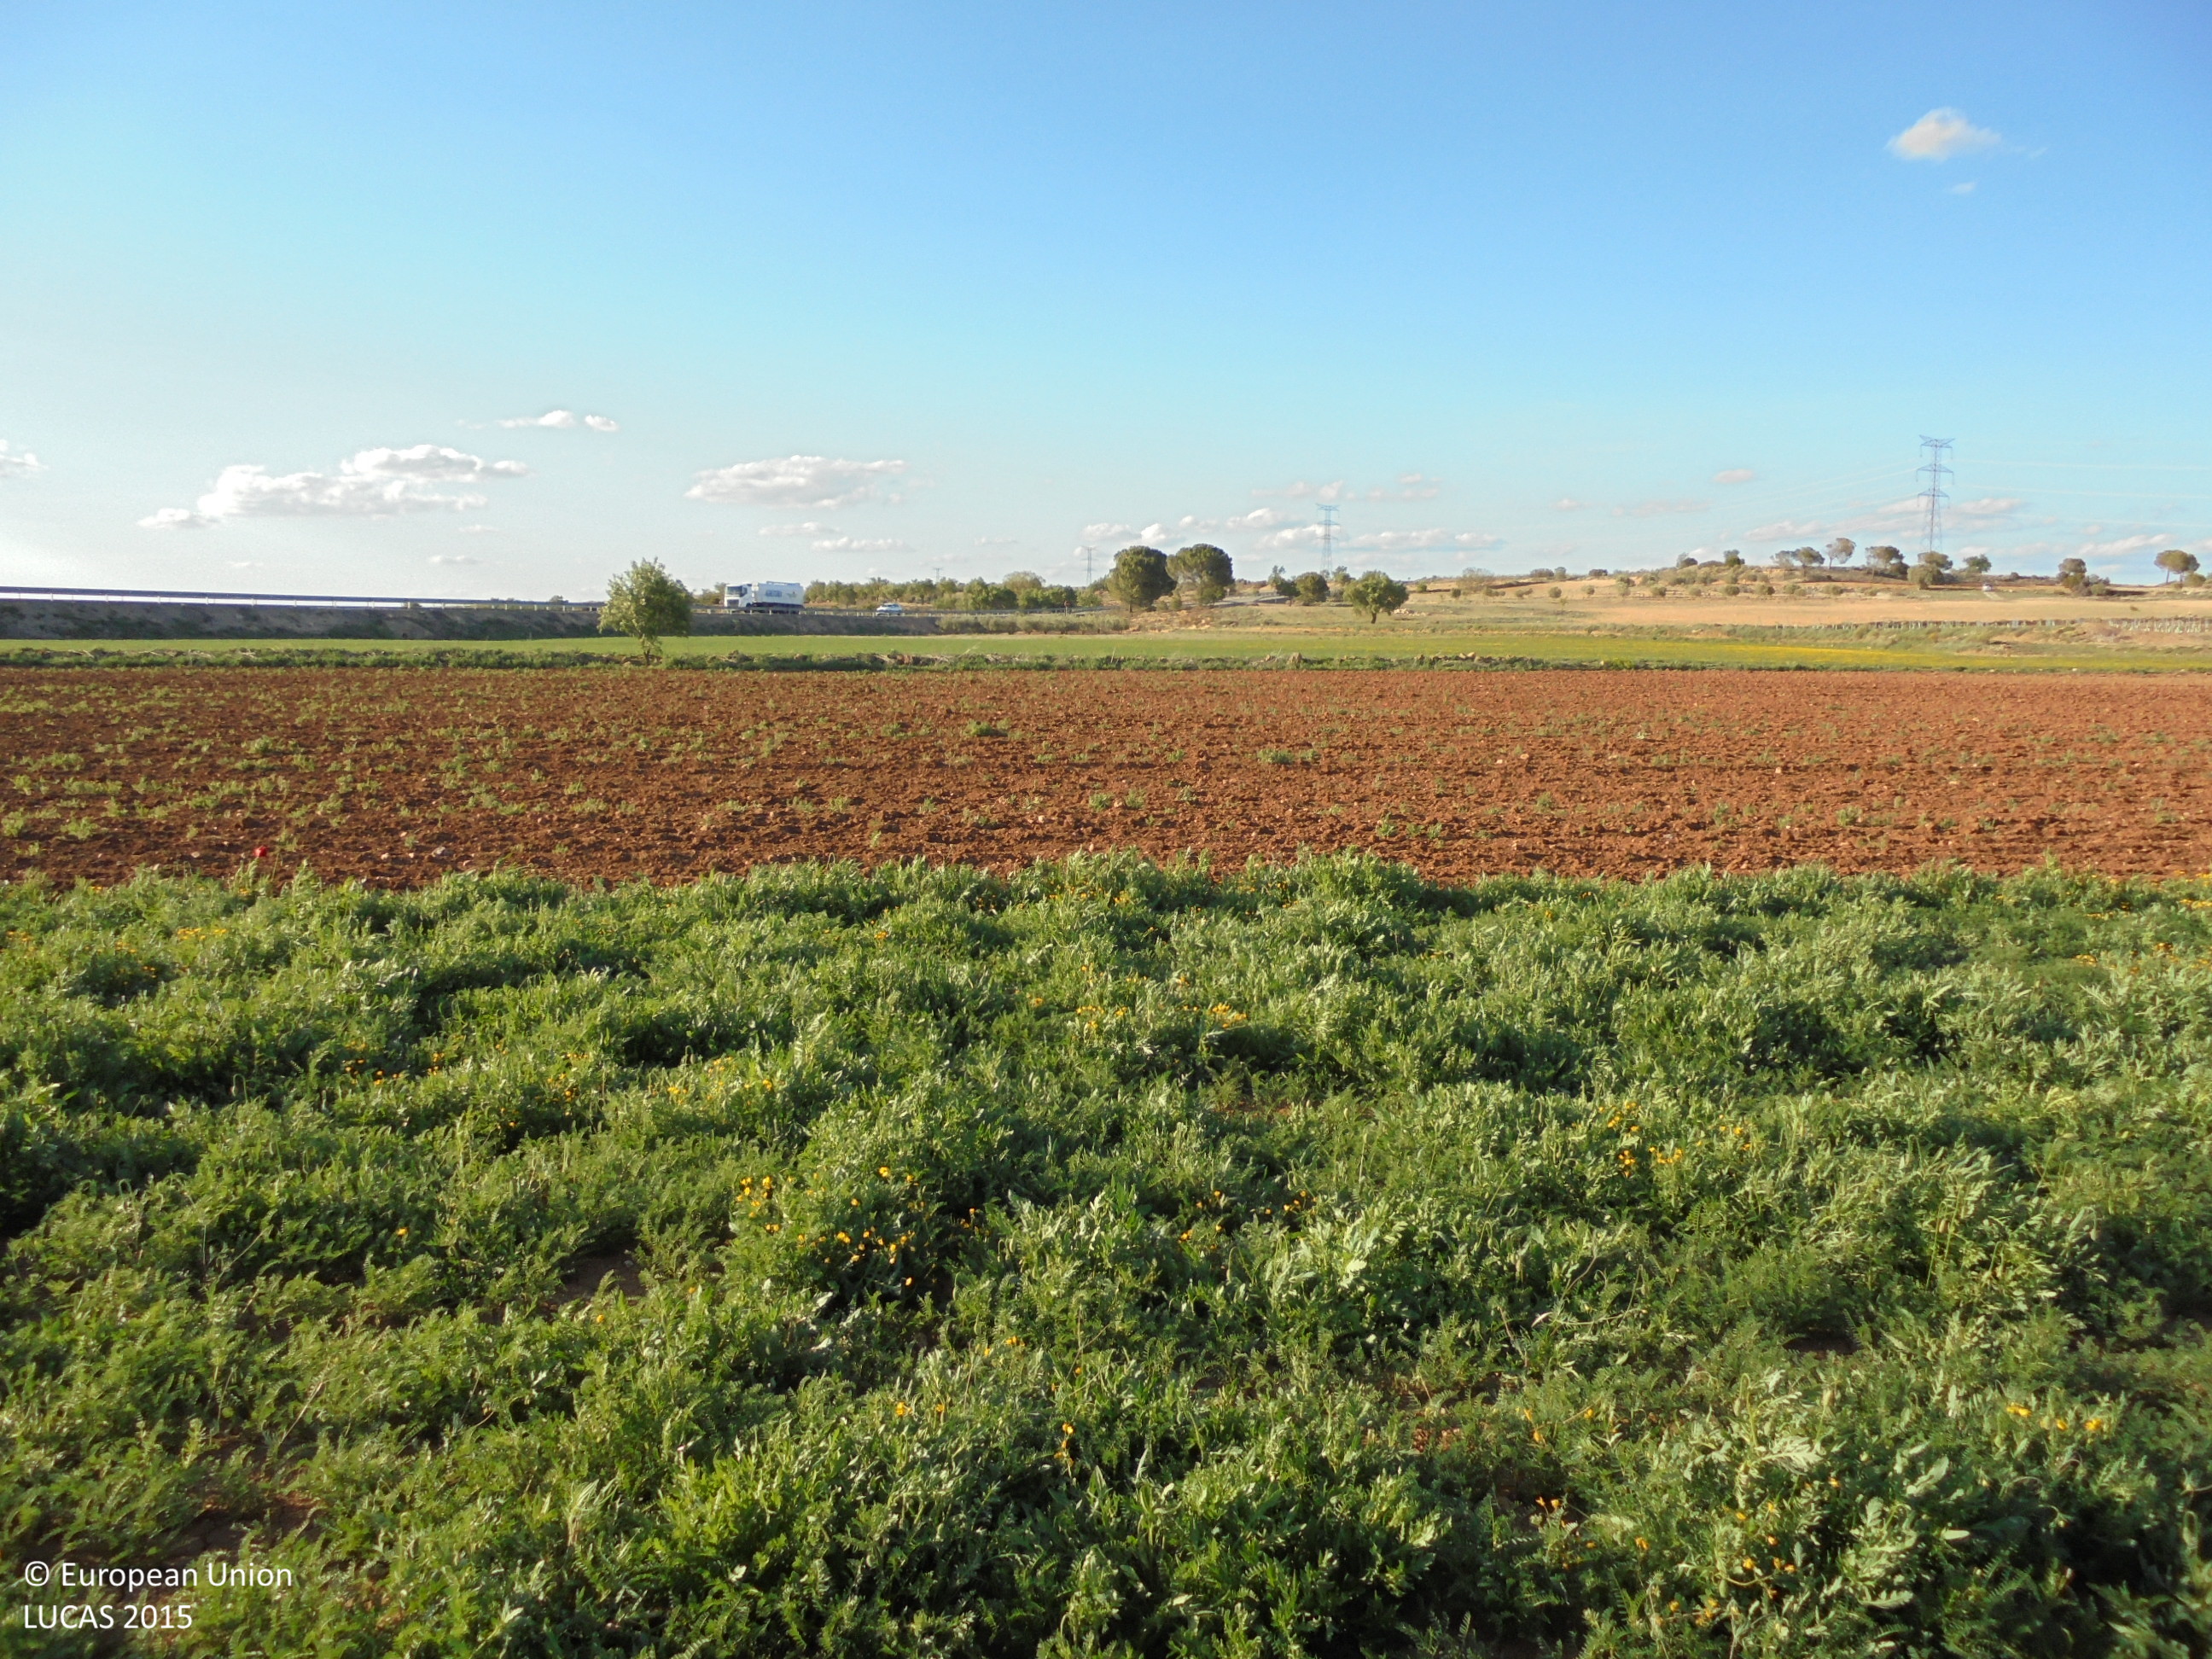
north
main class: Cropland
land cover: Dry pulses
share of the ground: > 75 %
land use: Agriculture (excluding fallow land and kitchen gardens)
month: April
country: ES
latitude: 39.2615
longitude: -1.7897
